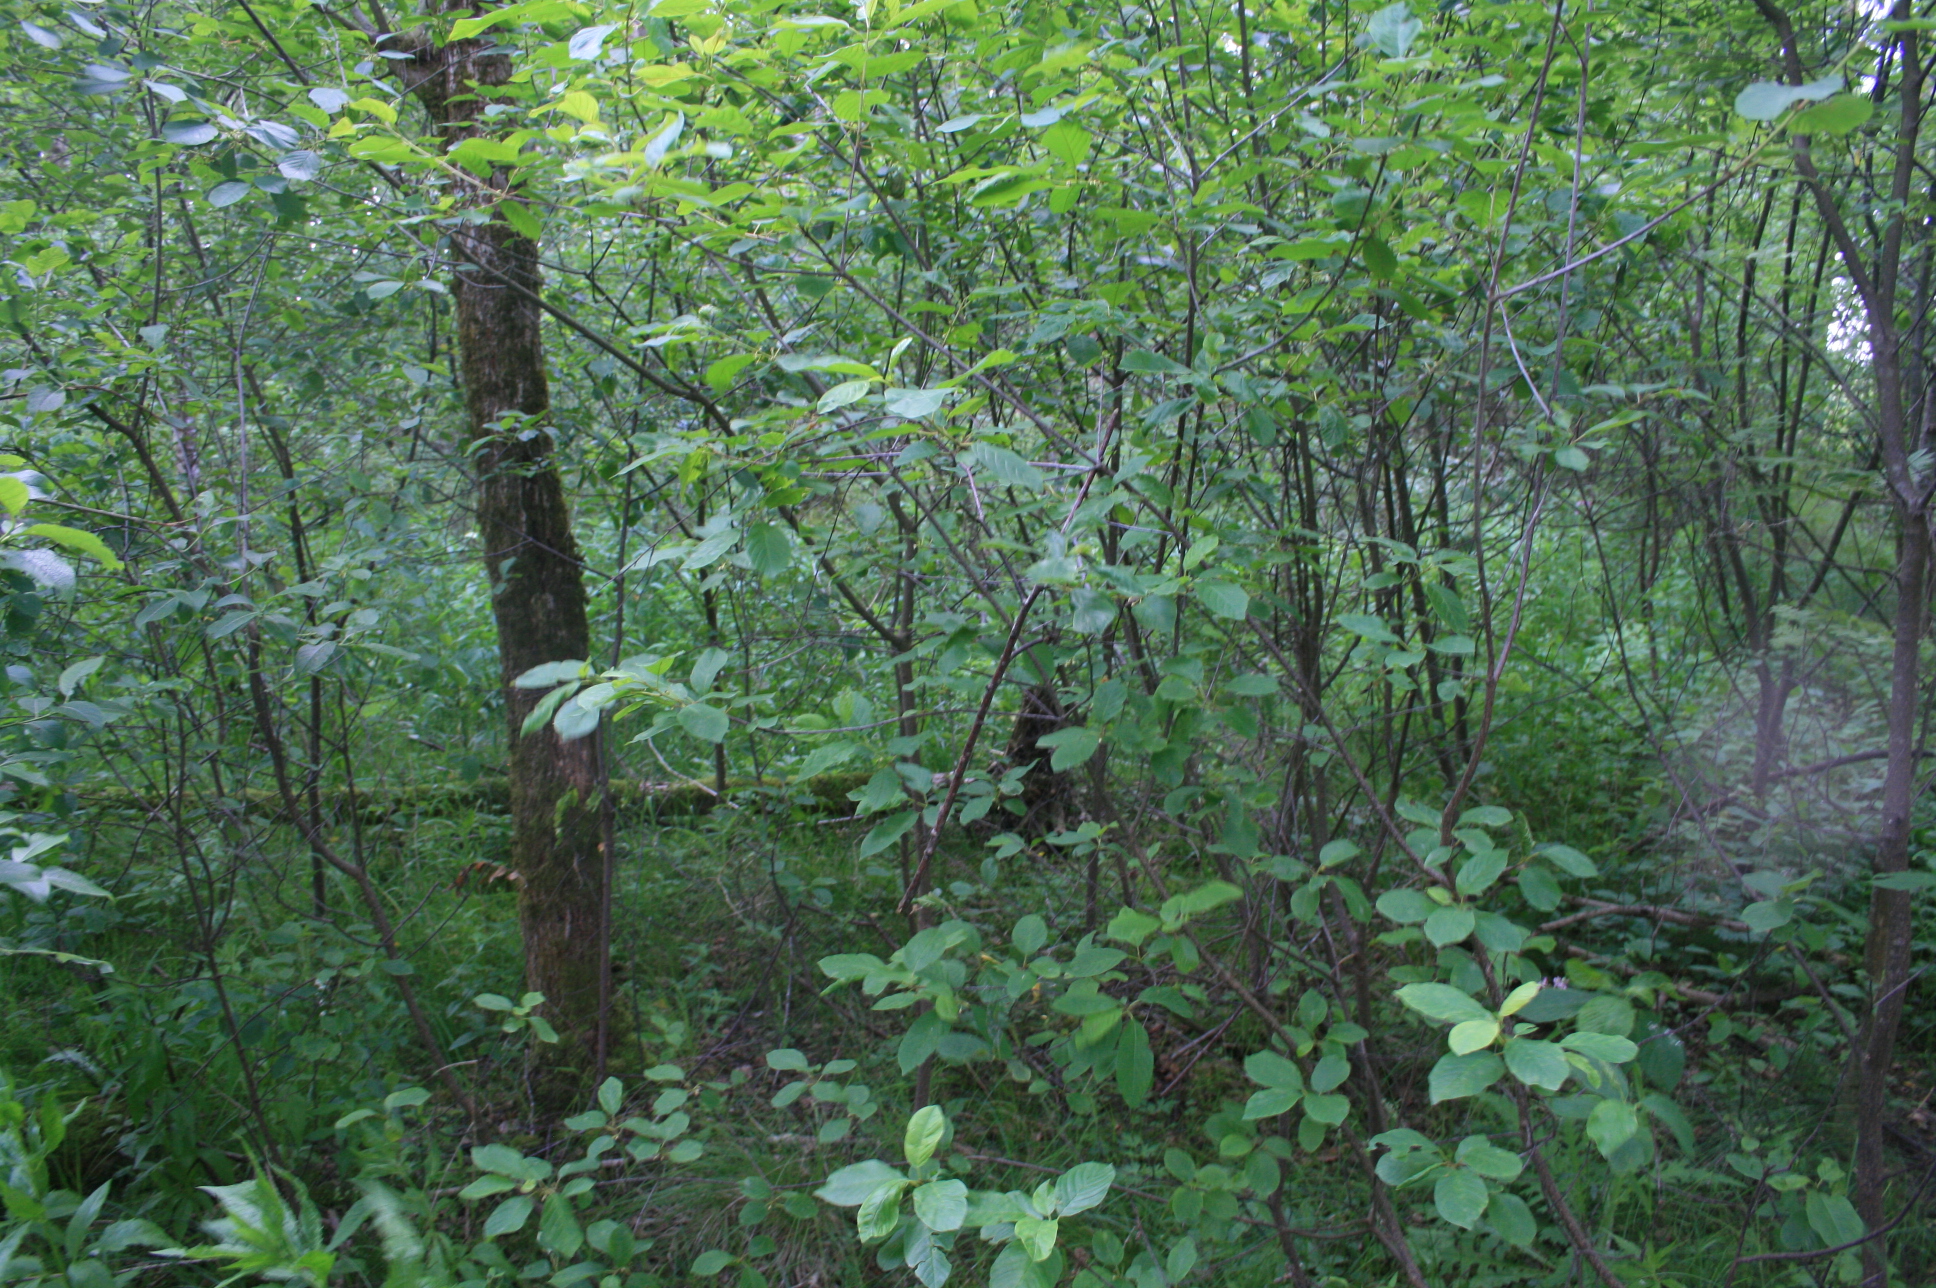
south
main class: Woodland
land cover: Broadleaved woodland
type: non-riverine alder, birch or aspen forest
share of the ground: > 75 %
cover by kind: broadleaved forest trees 90 %, herbaceous plants 10 %
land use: Forestry
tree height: > 5 m
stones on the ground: < 10 %
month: June
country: LT
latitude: 55.3324
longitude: 21.7945
